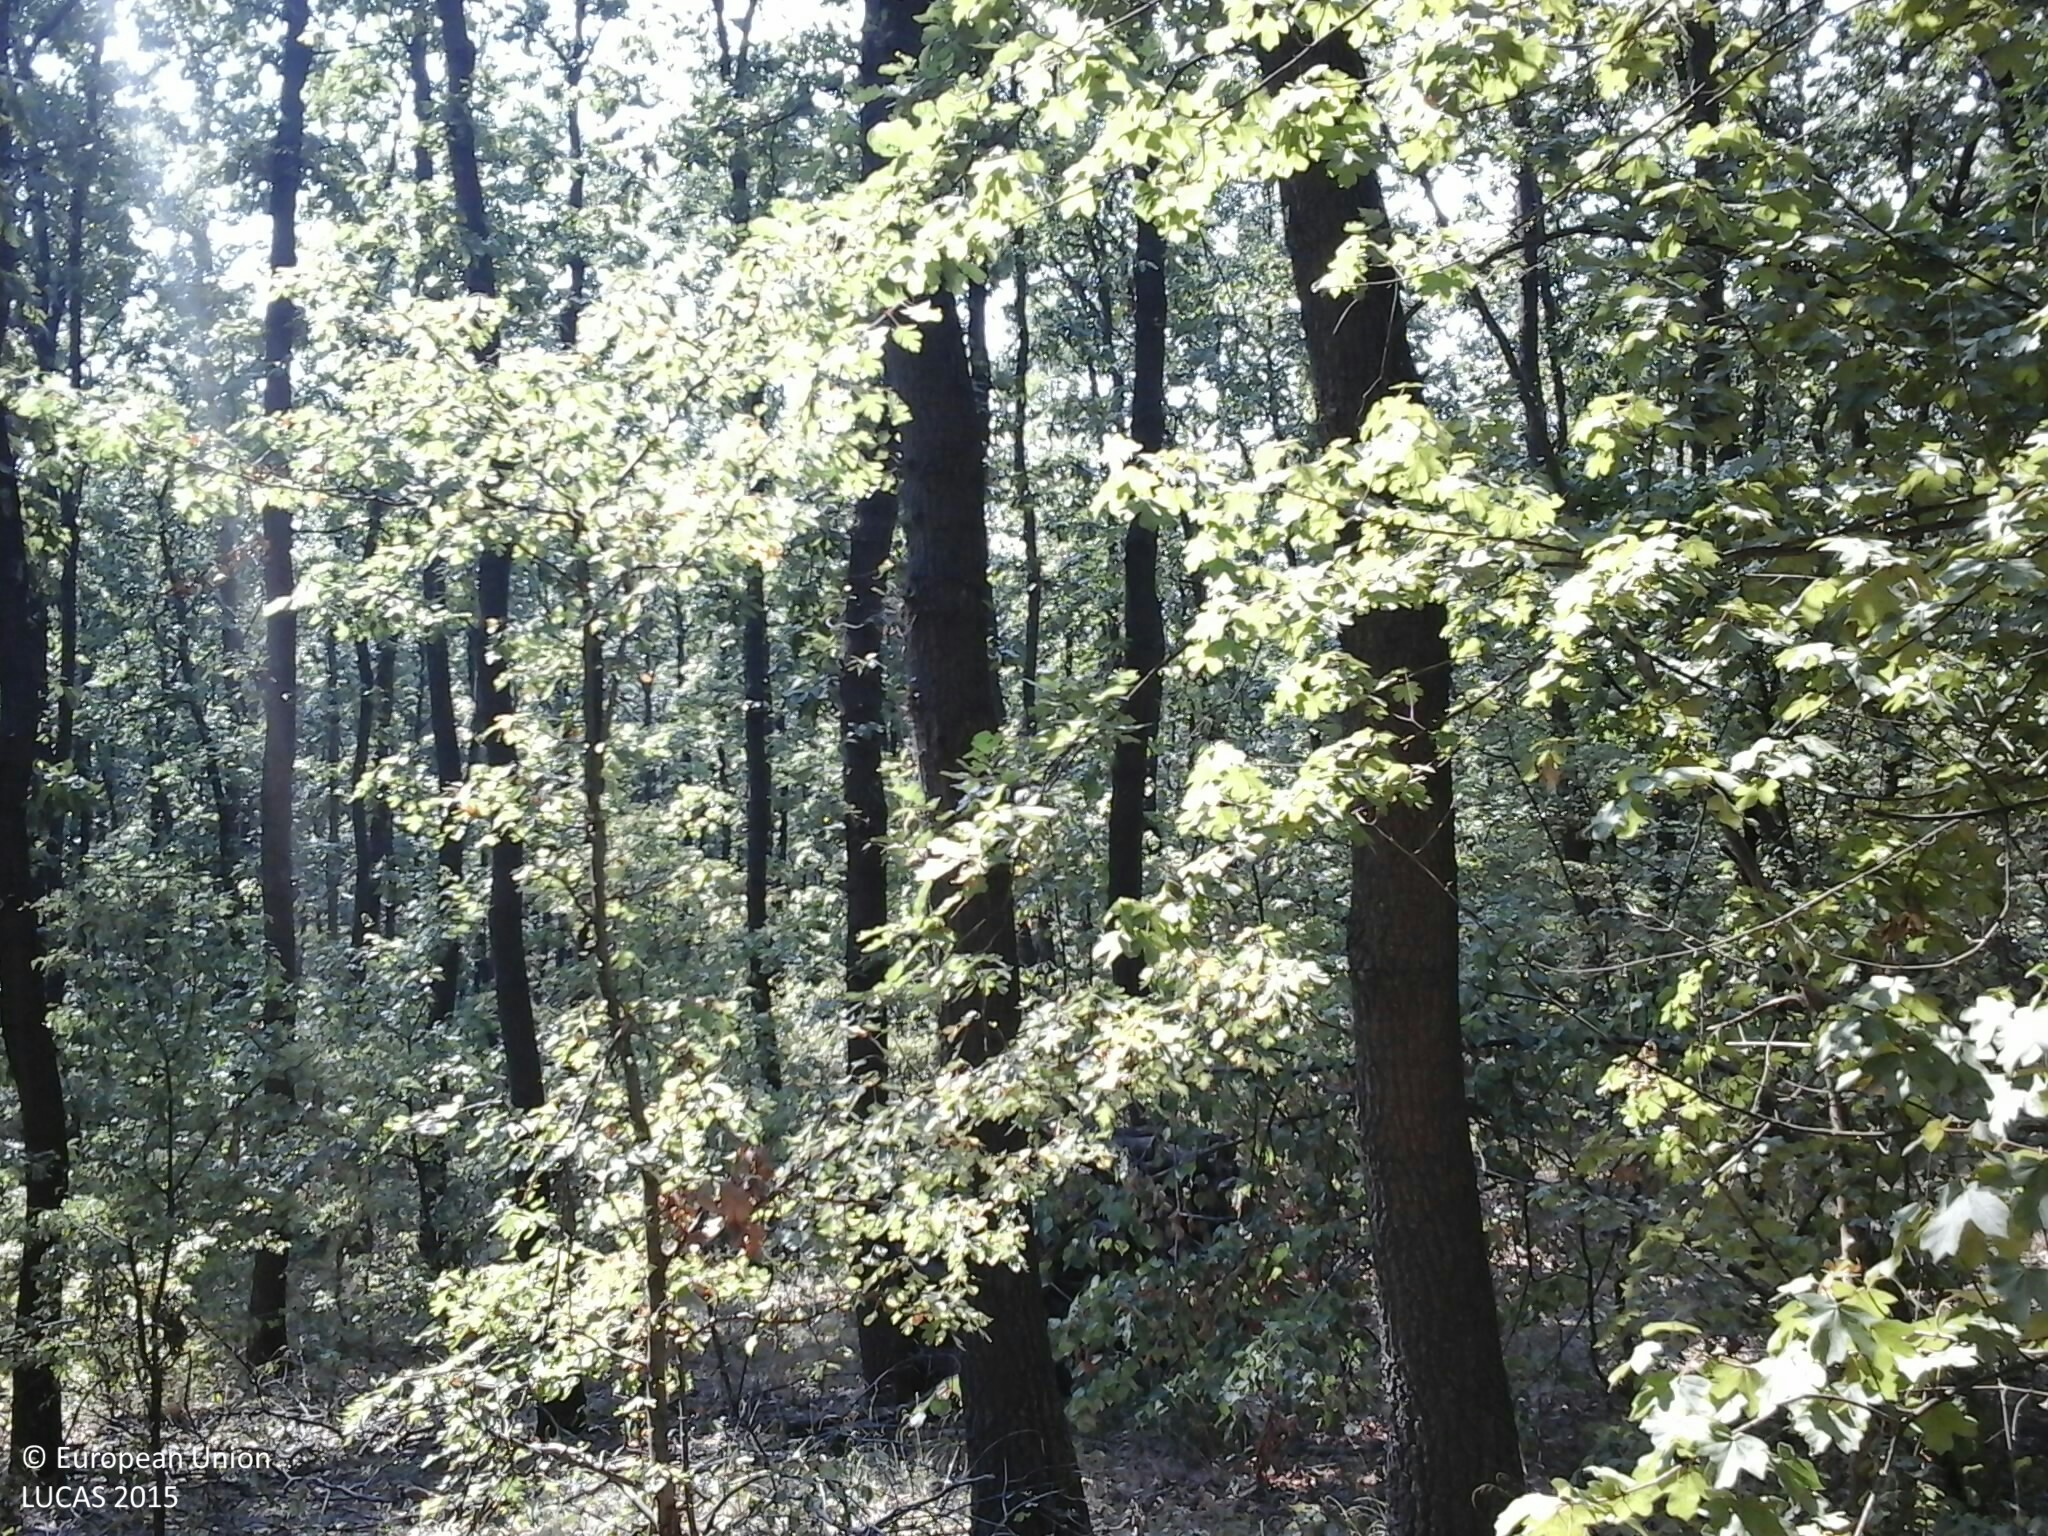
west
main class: Woodland
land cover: Broadleaved woodland
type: thermophilous deciduous forest
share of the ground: > 75 %
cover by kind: broadleaved forest trees 70 %, shrubs 20 %, herbaceous plants 10 %
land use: Forestry
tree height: > 5 m
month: August
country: HU
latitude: 47.9519
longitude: 19.1388
